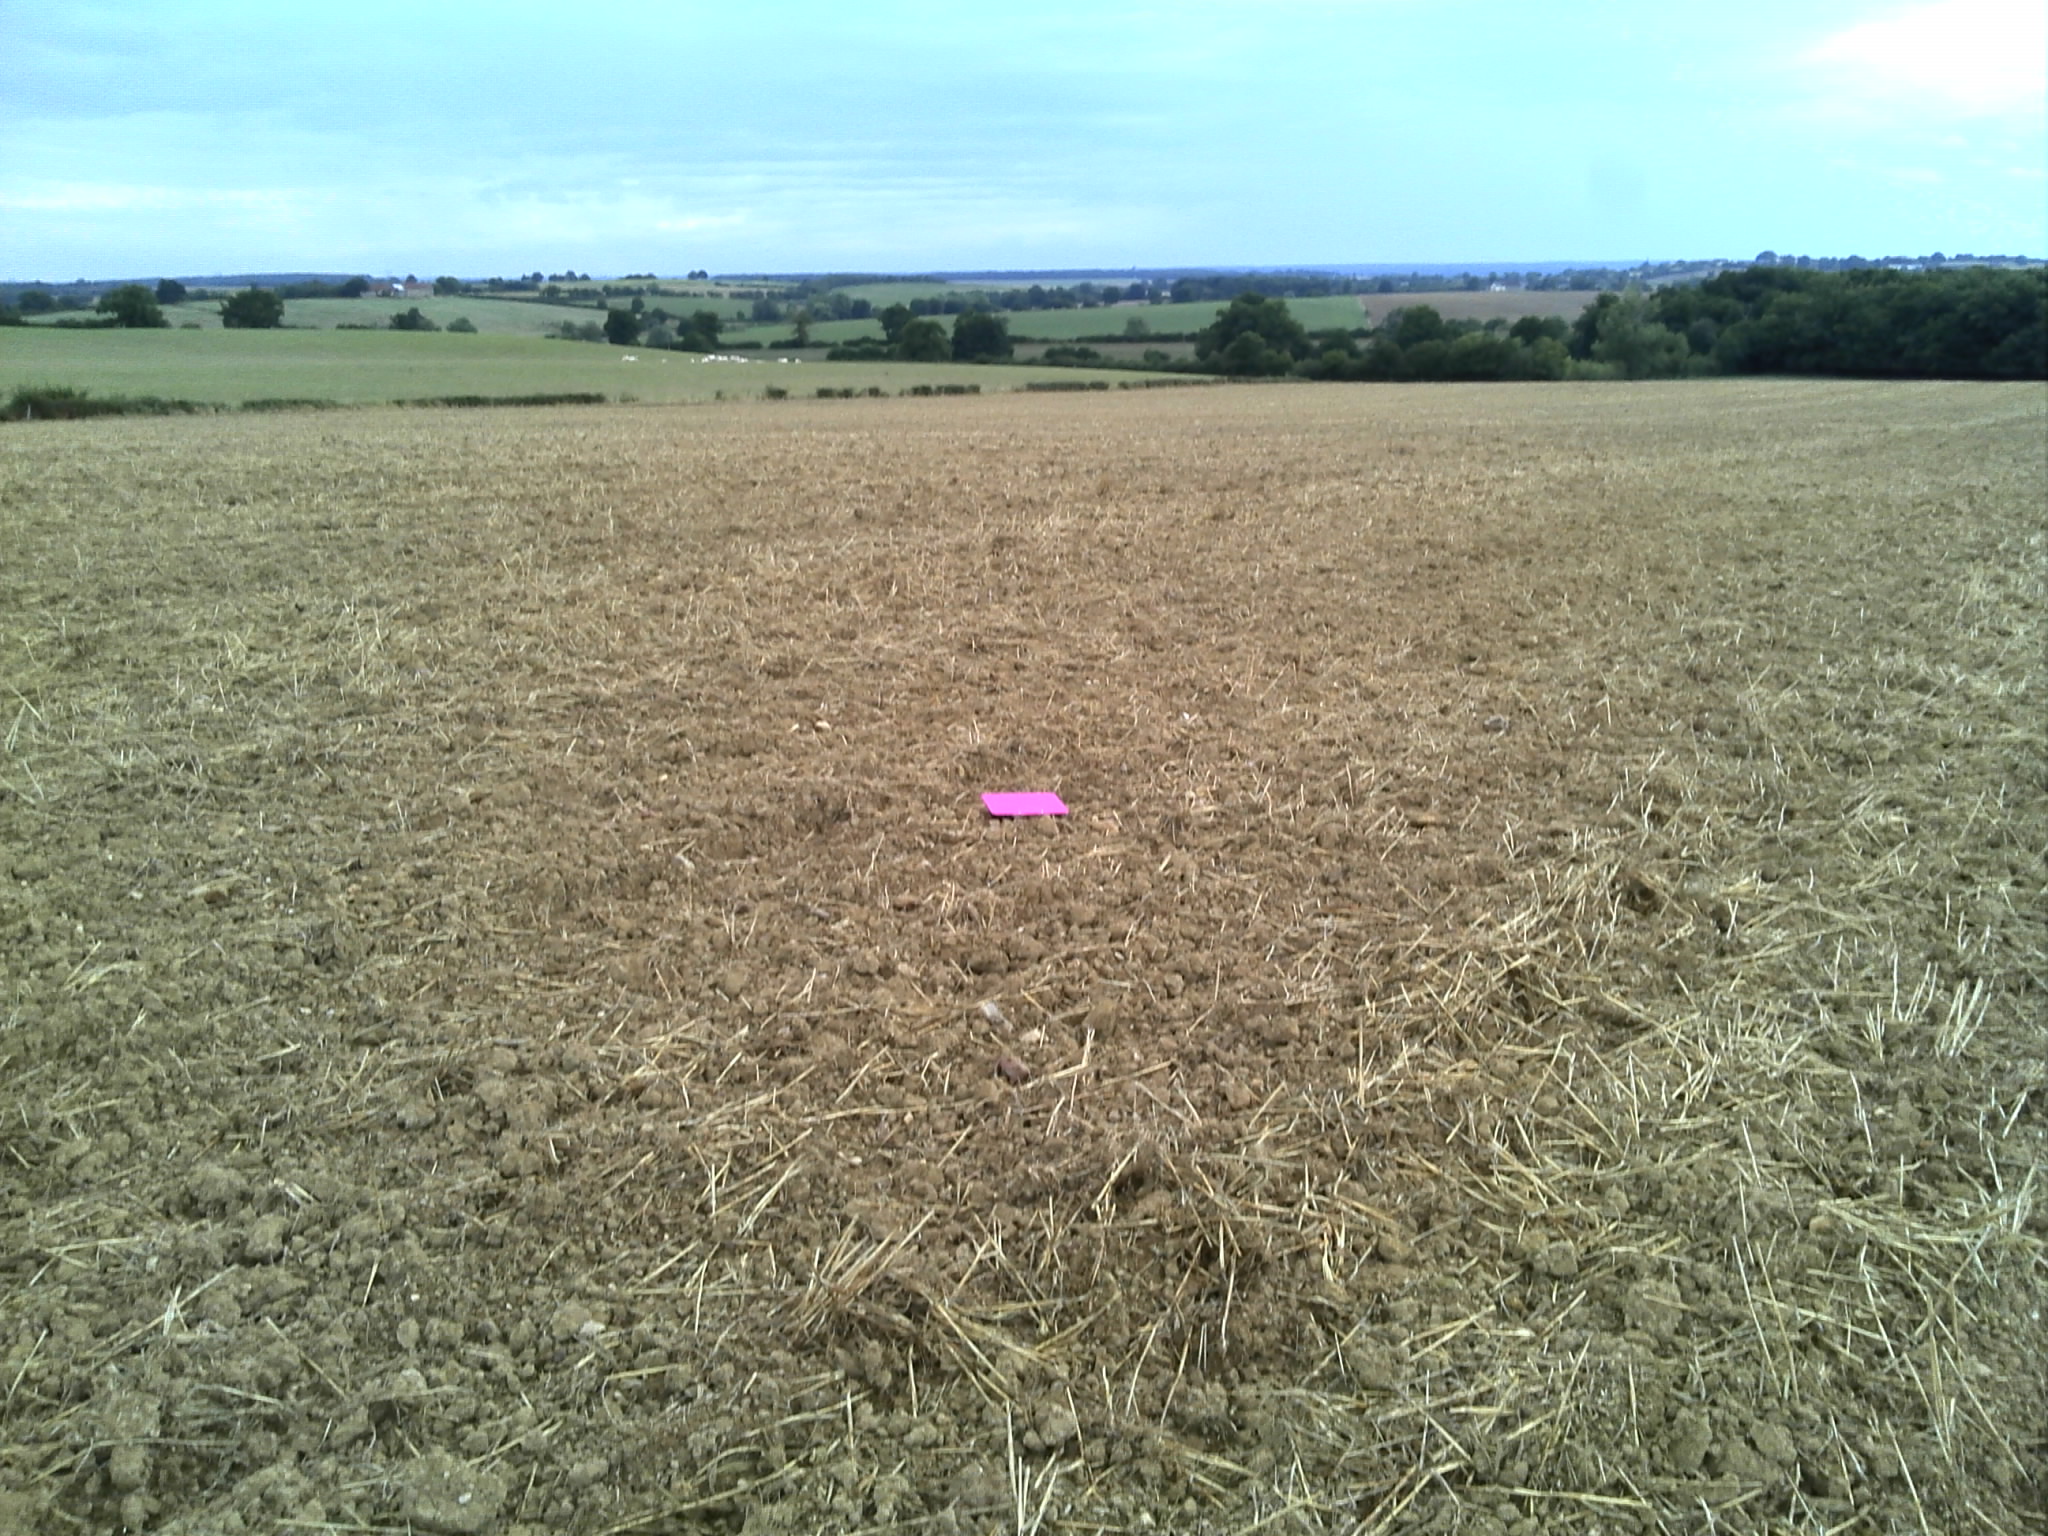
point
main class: Cropland
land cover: Common wheat
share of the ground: > 75 %
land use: Agriculture (excluding fallow land and kitchen gardens)
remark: Tilled/Sowed
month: August
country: FR
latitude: 46.6247
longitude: 2.1700
